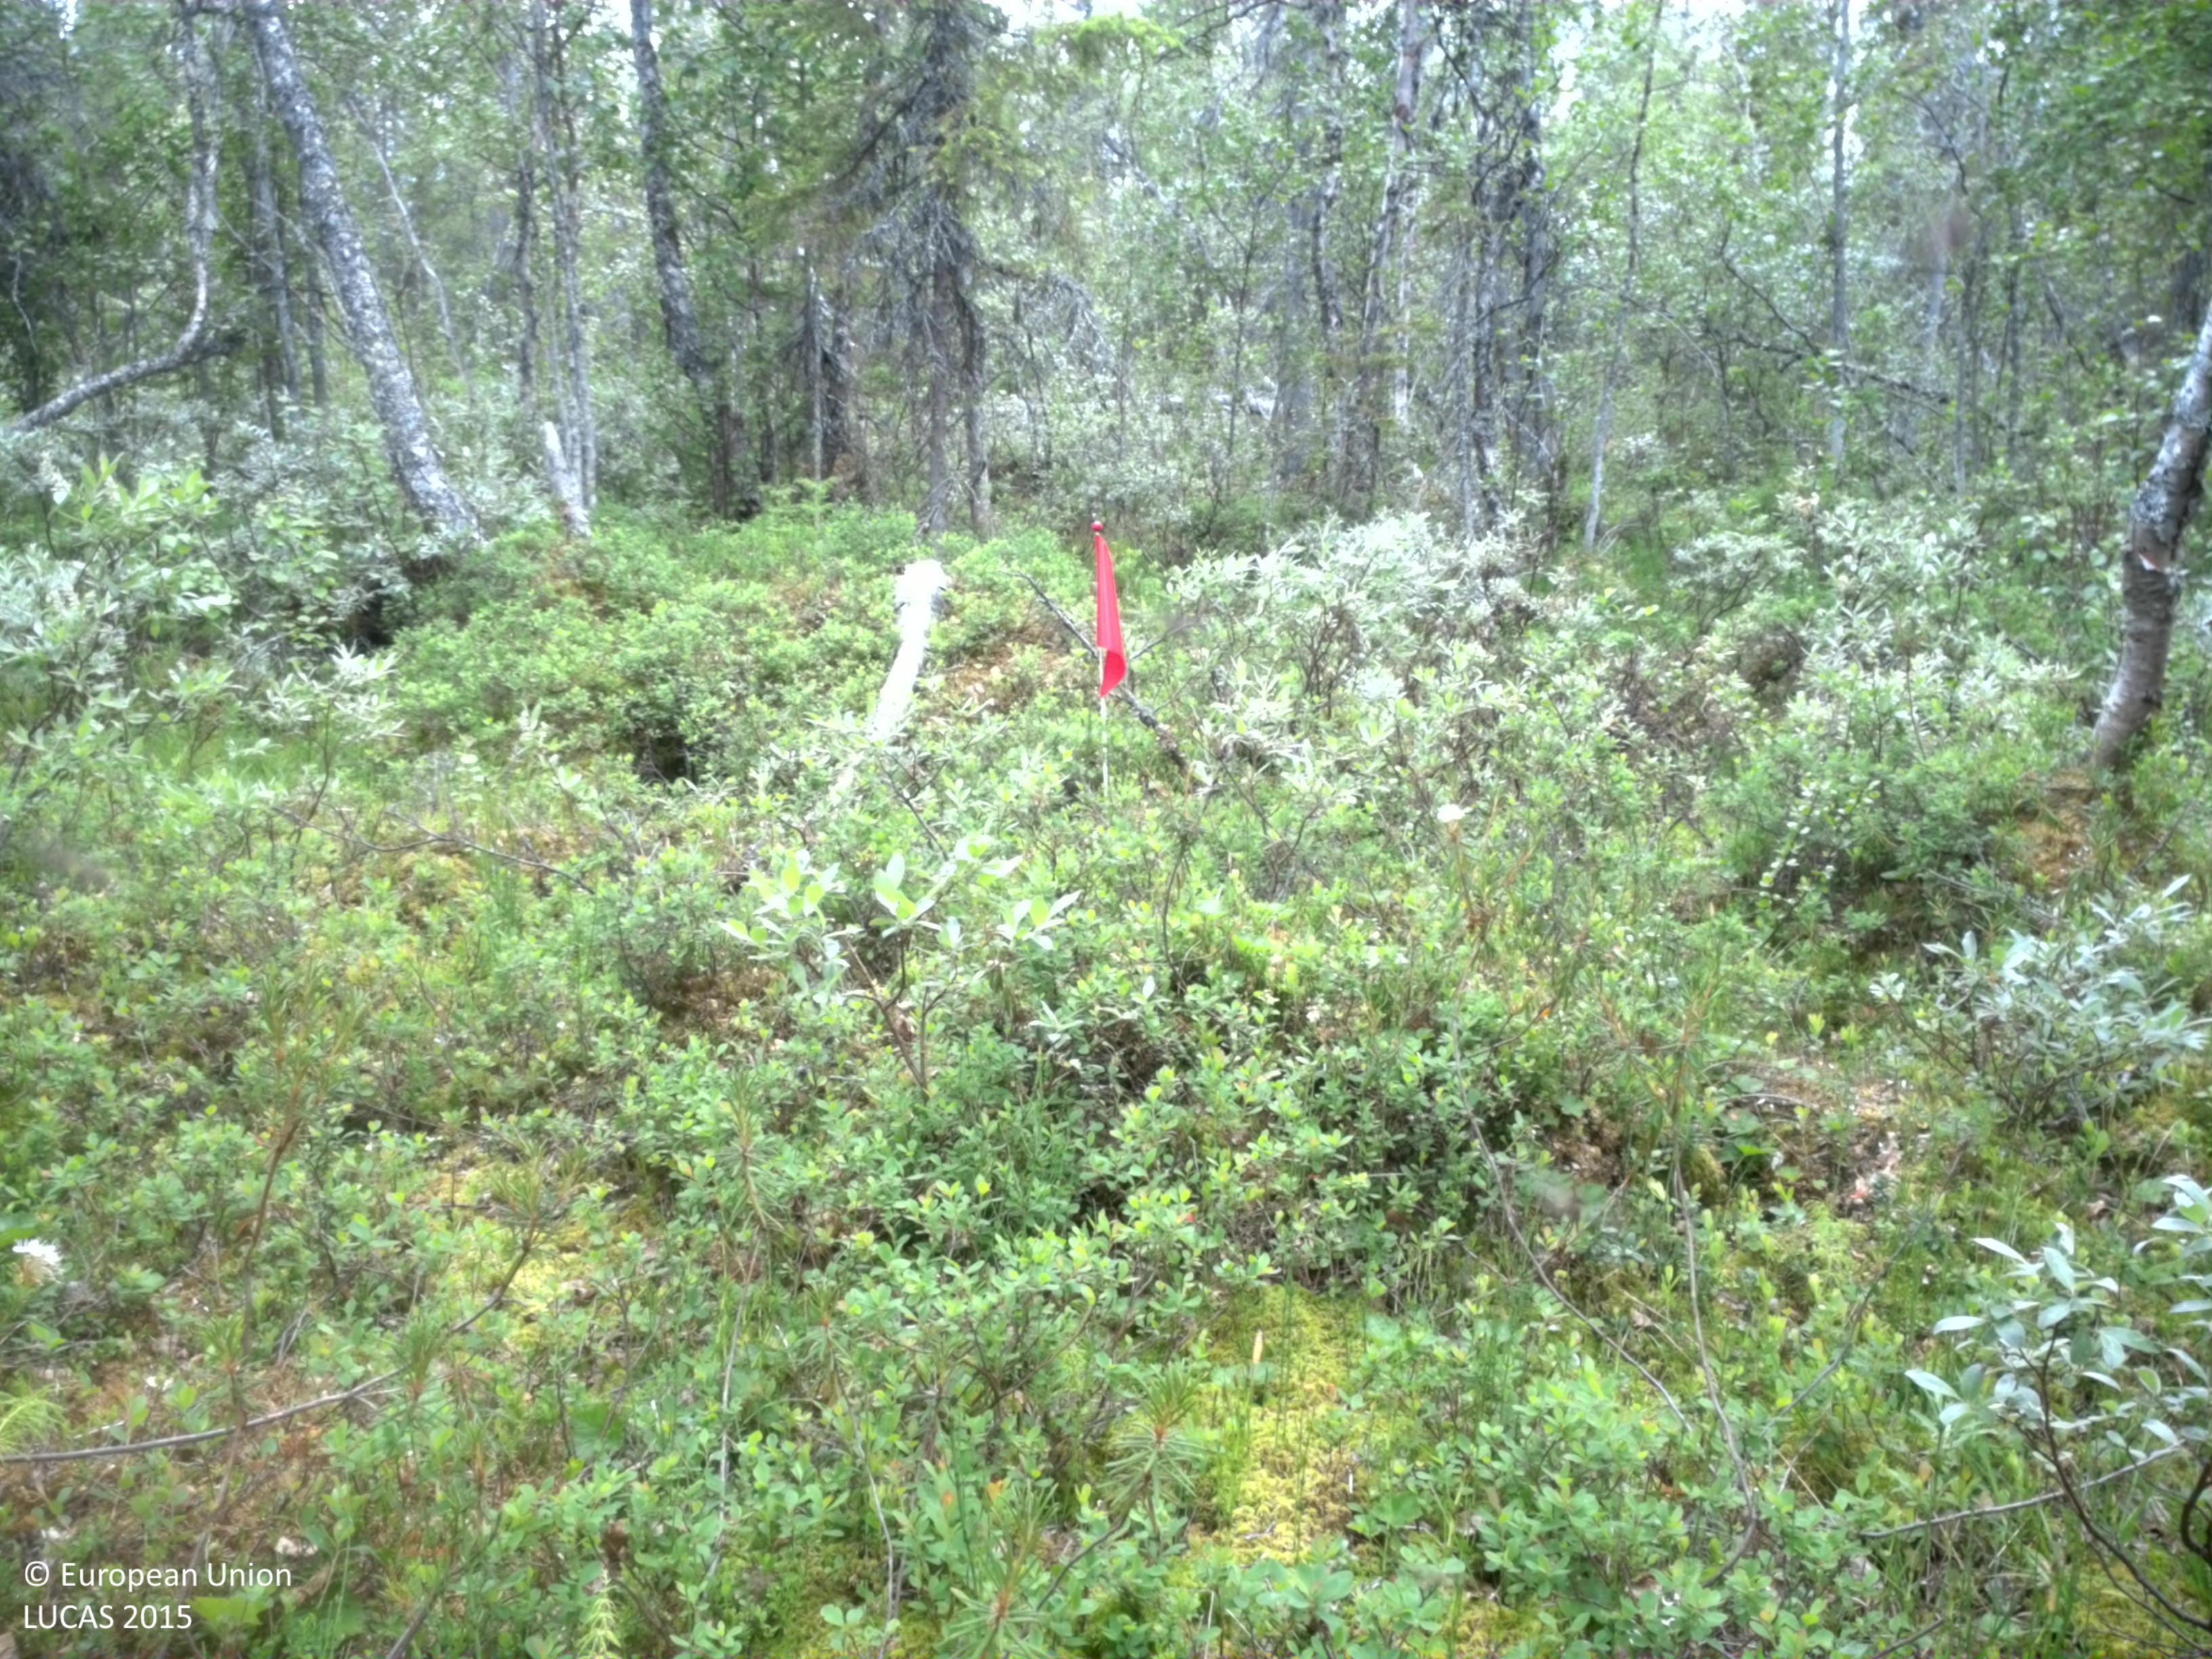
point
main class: Woodland
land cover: Spruce dominated mixed woodland
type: mire and swamp forests
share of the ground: 50 - 75 %
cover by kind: shrubs 40 %, coniferous forest trees 35 %, broadleaved forest trees 20 %, lichens and mosses 5 %
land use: Forestry
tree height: > 5 m
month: July
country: SE
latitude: 67.2688
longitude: 19.1506
